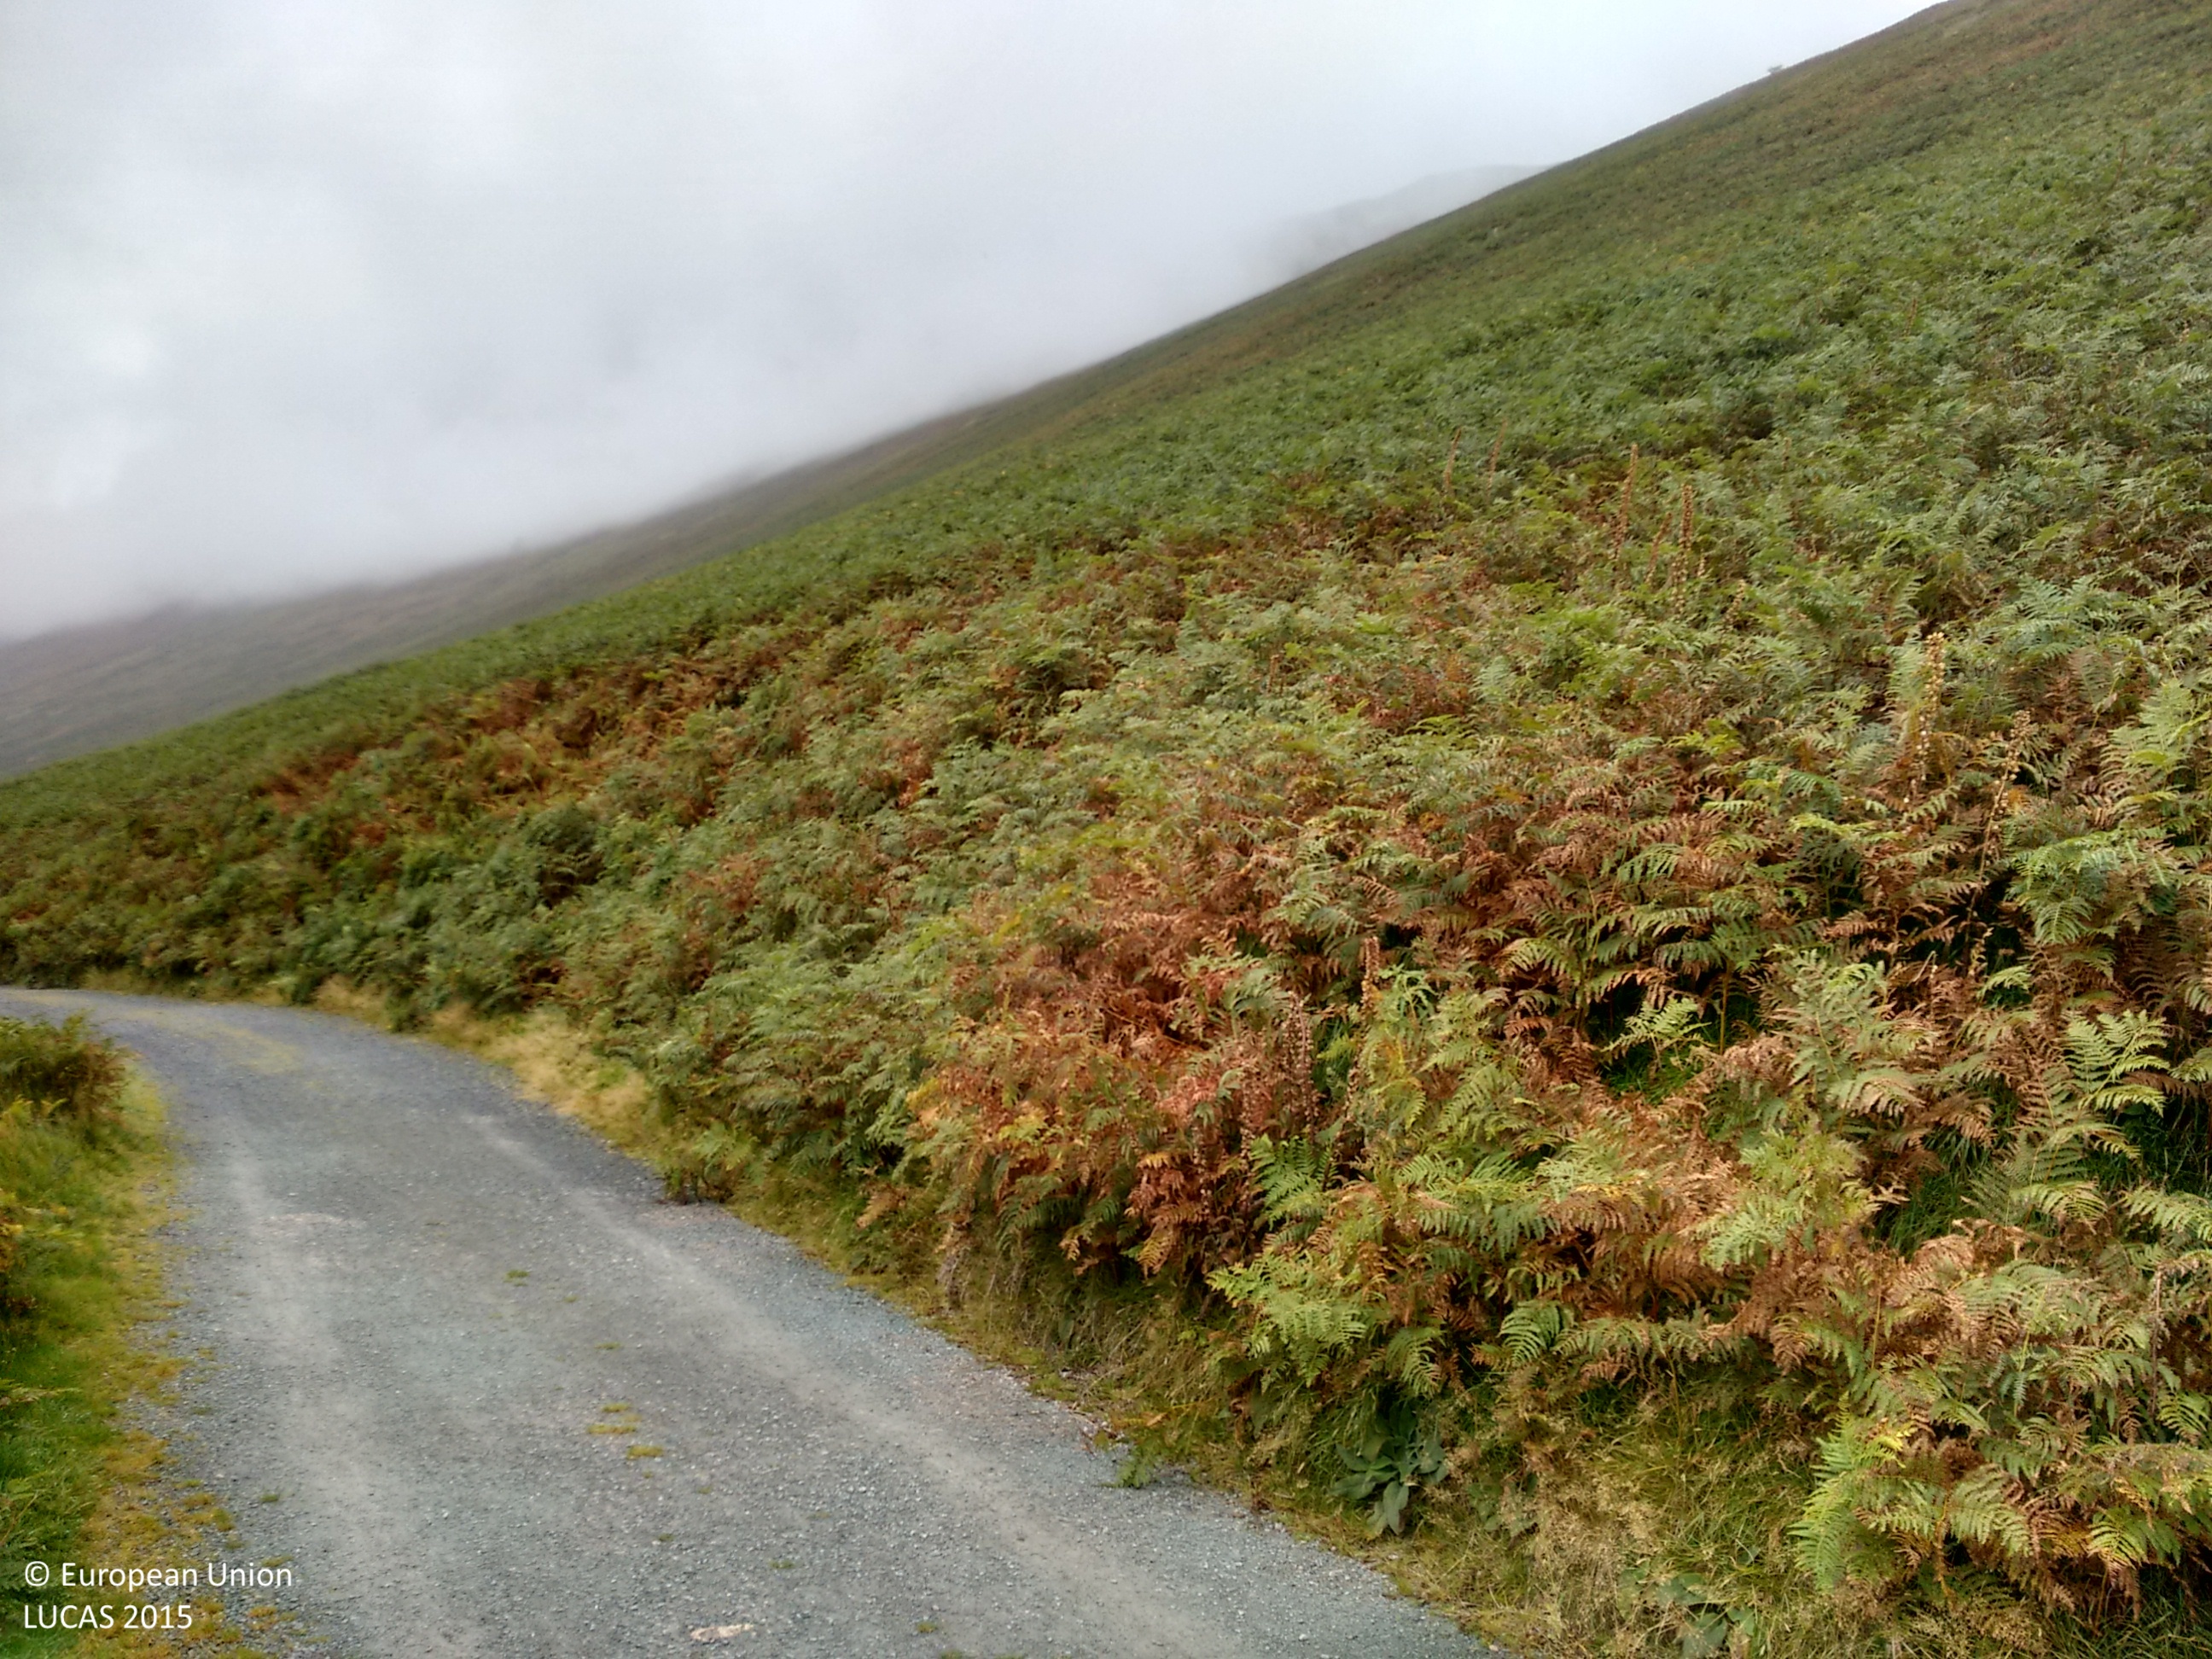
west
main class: Shrubland
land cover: Shrubland without tree cover
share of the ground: > 75 %
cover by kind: shrubs 100 %
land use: Agriculture (excluding fallow land and kitchen gardens)
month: October
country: GB
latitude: 54.5882
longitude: -3.2143
